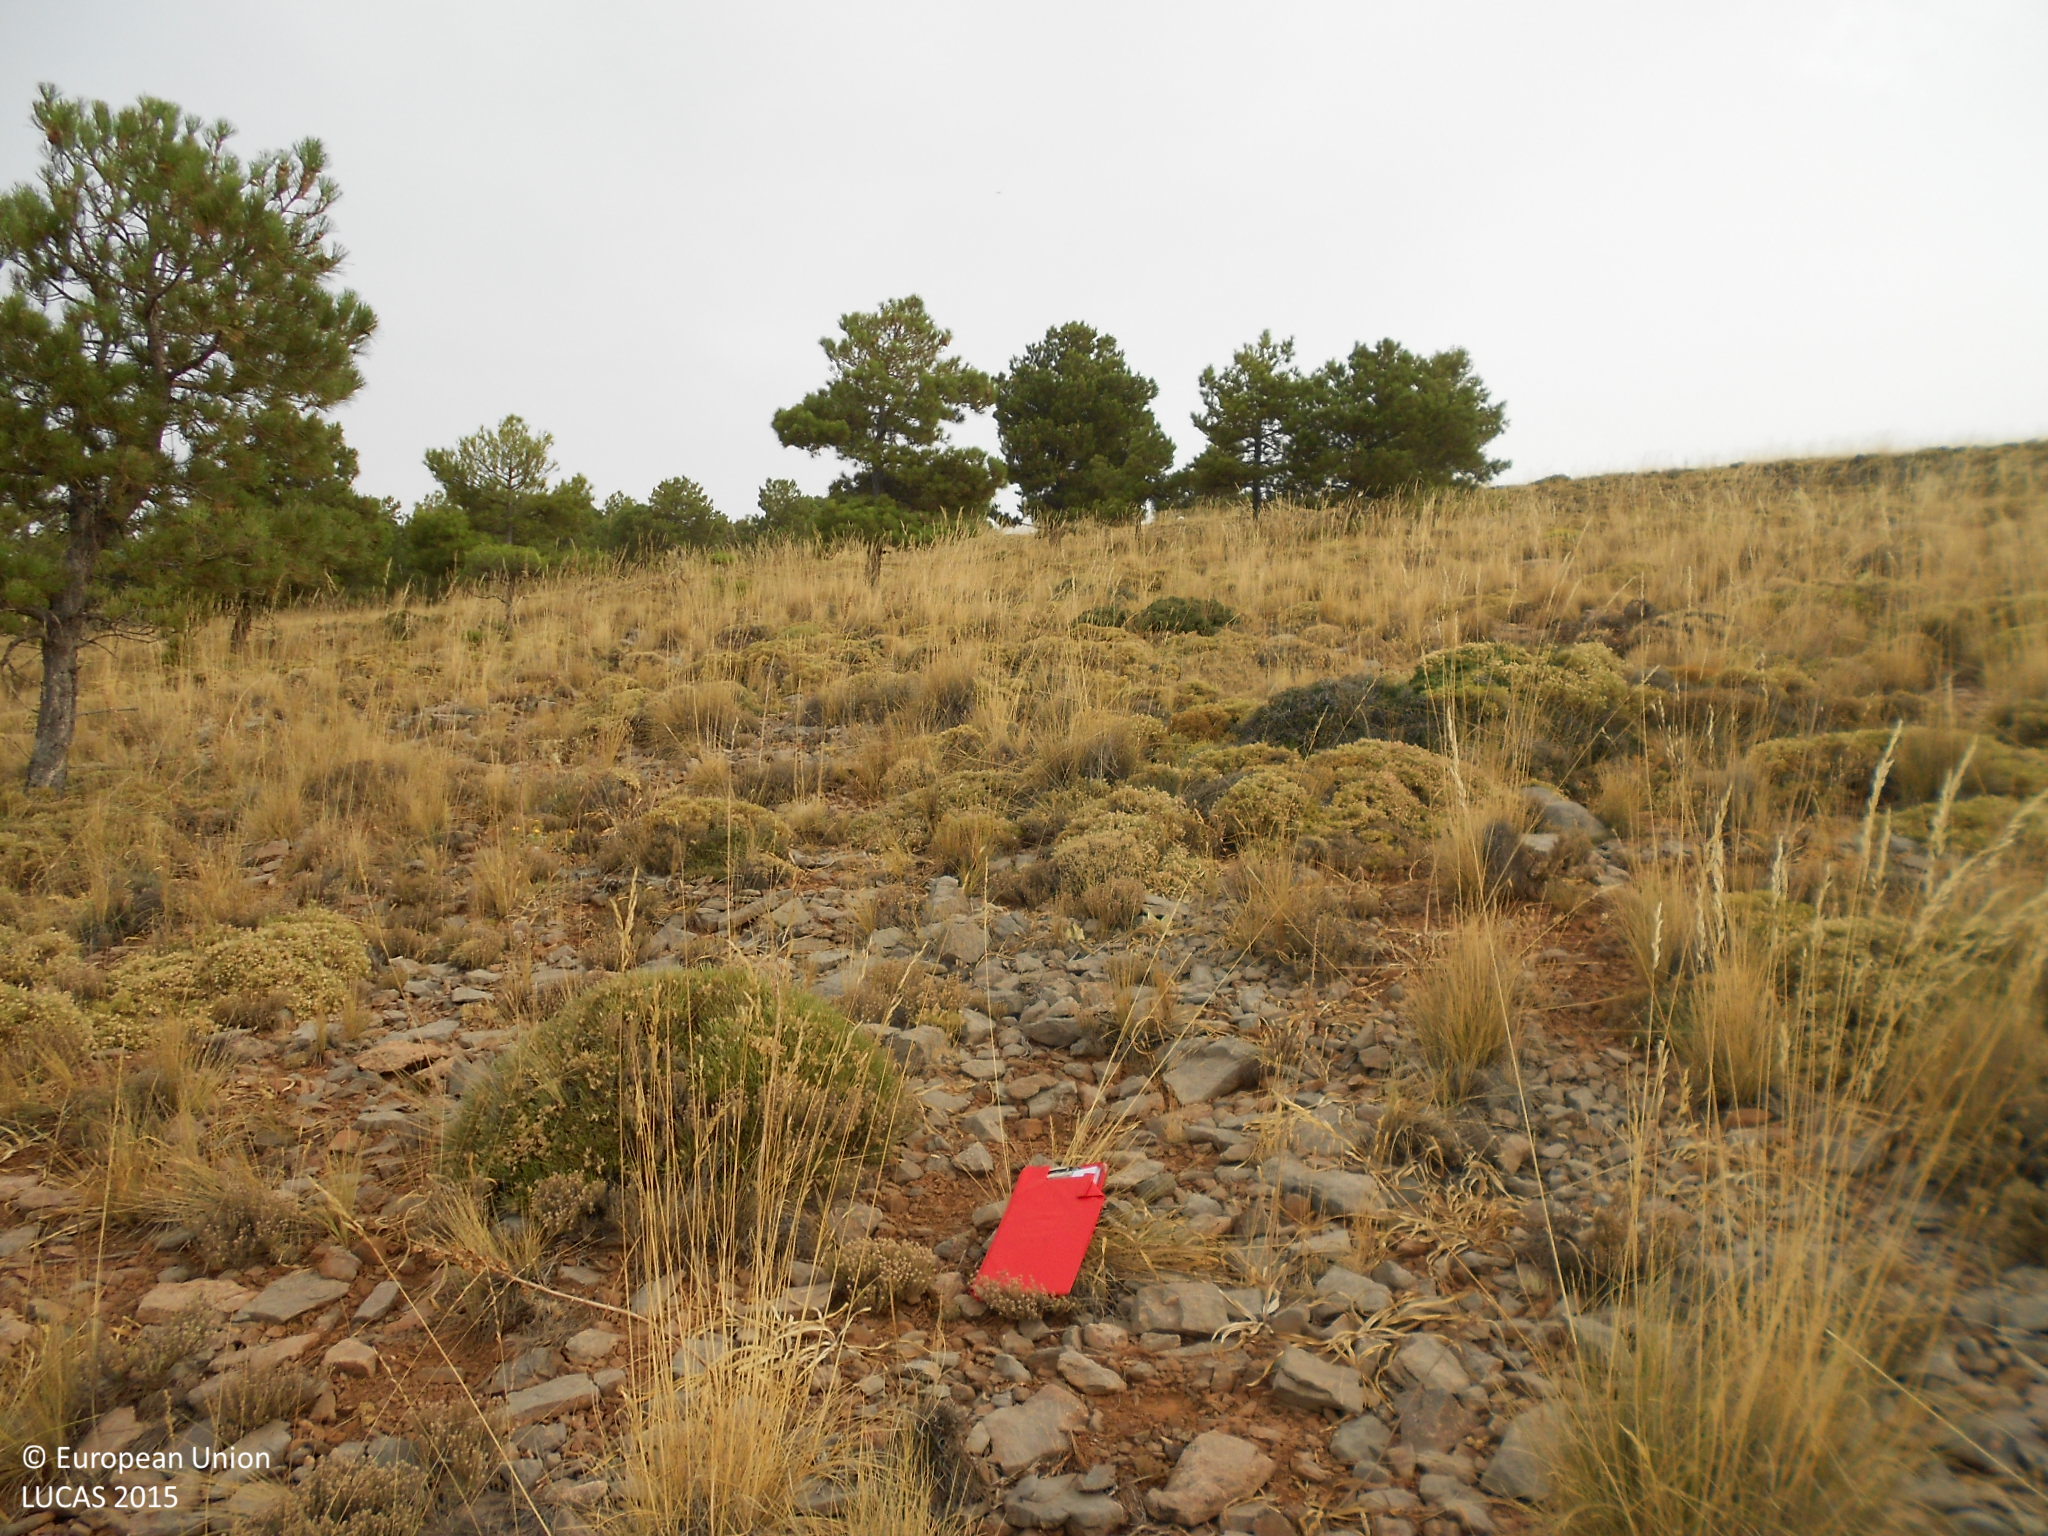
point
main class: Shrubland
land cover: Shrubland with sparse tree cover
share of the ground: 25 - 50 %
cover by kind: consolidated bare surface 50 %, herbaceous plants 25 %, shrubs 20 %, coniferous forest trees 5 %
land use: Semi-natural and natural areas not in use
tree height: > 5 m
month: August
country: ES
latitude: 36.8724
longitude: -2.8456
